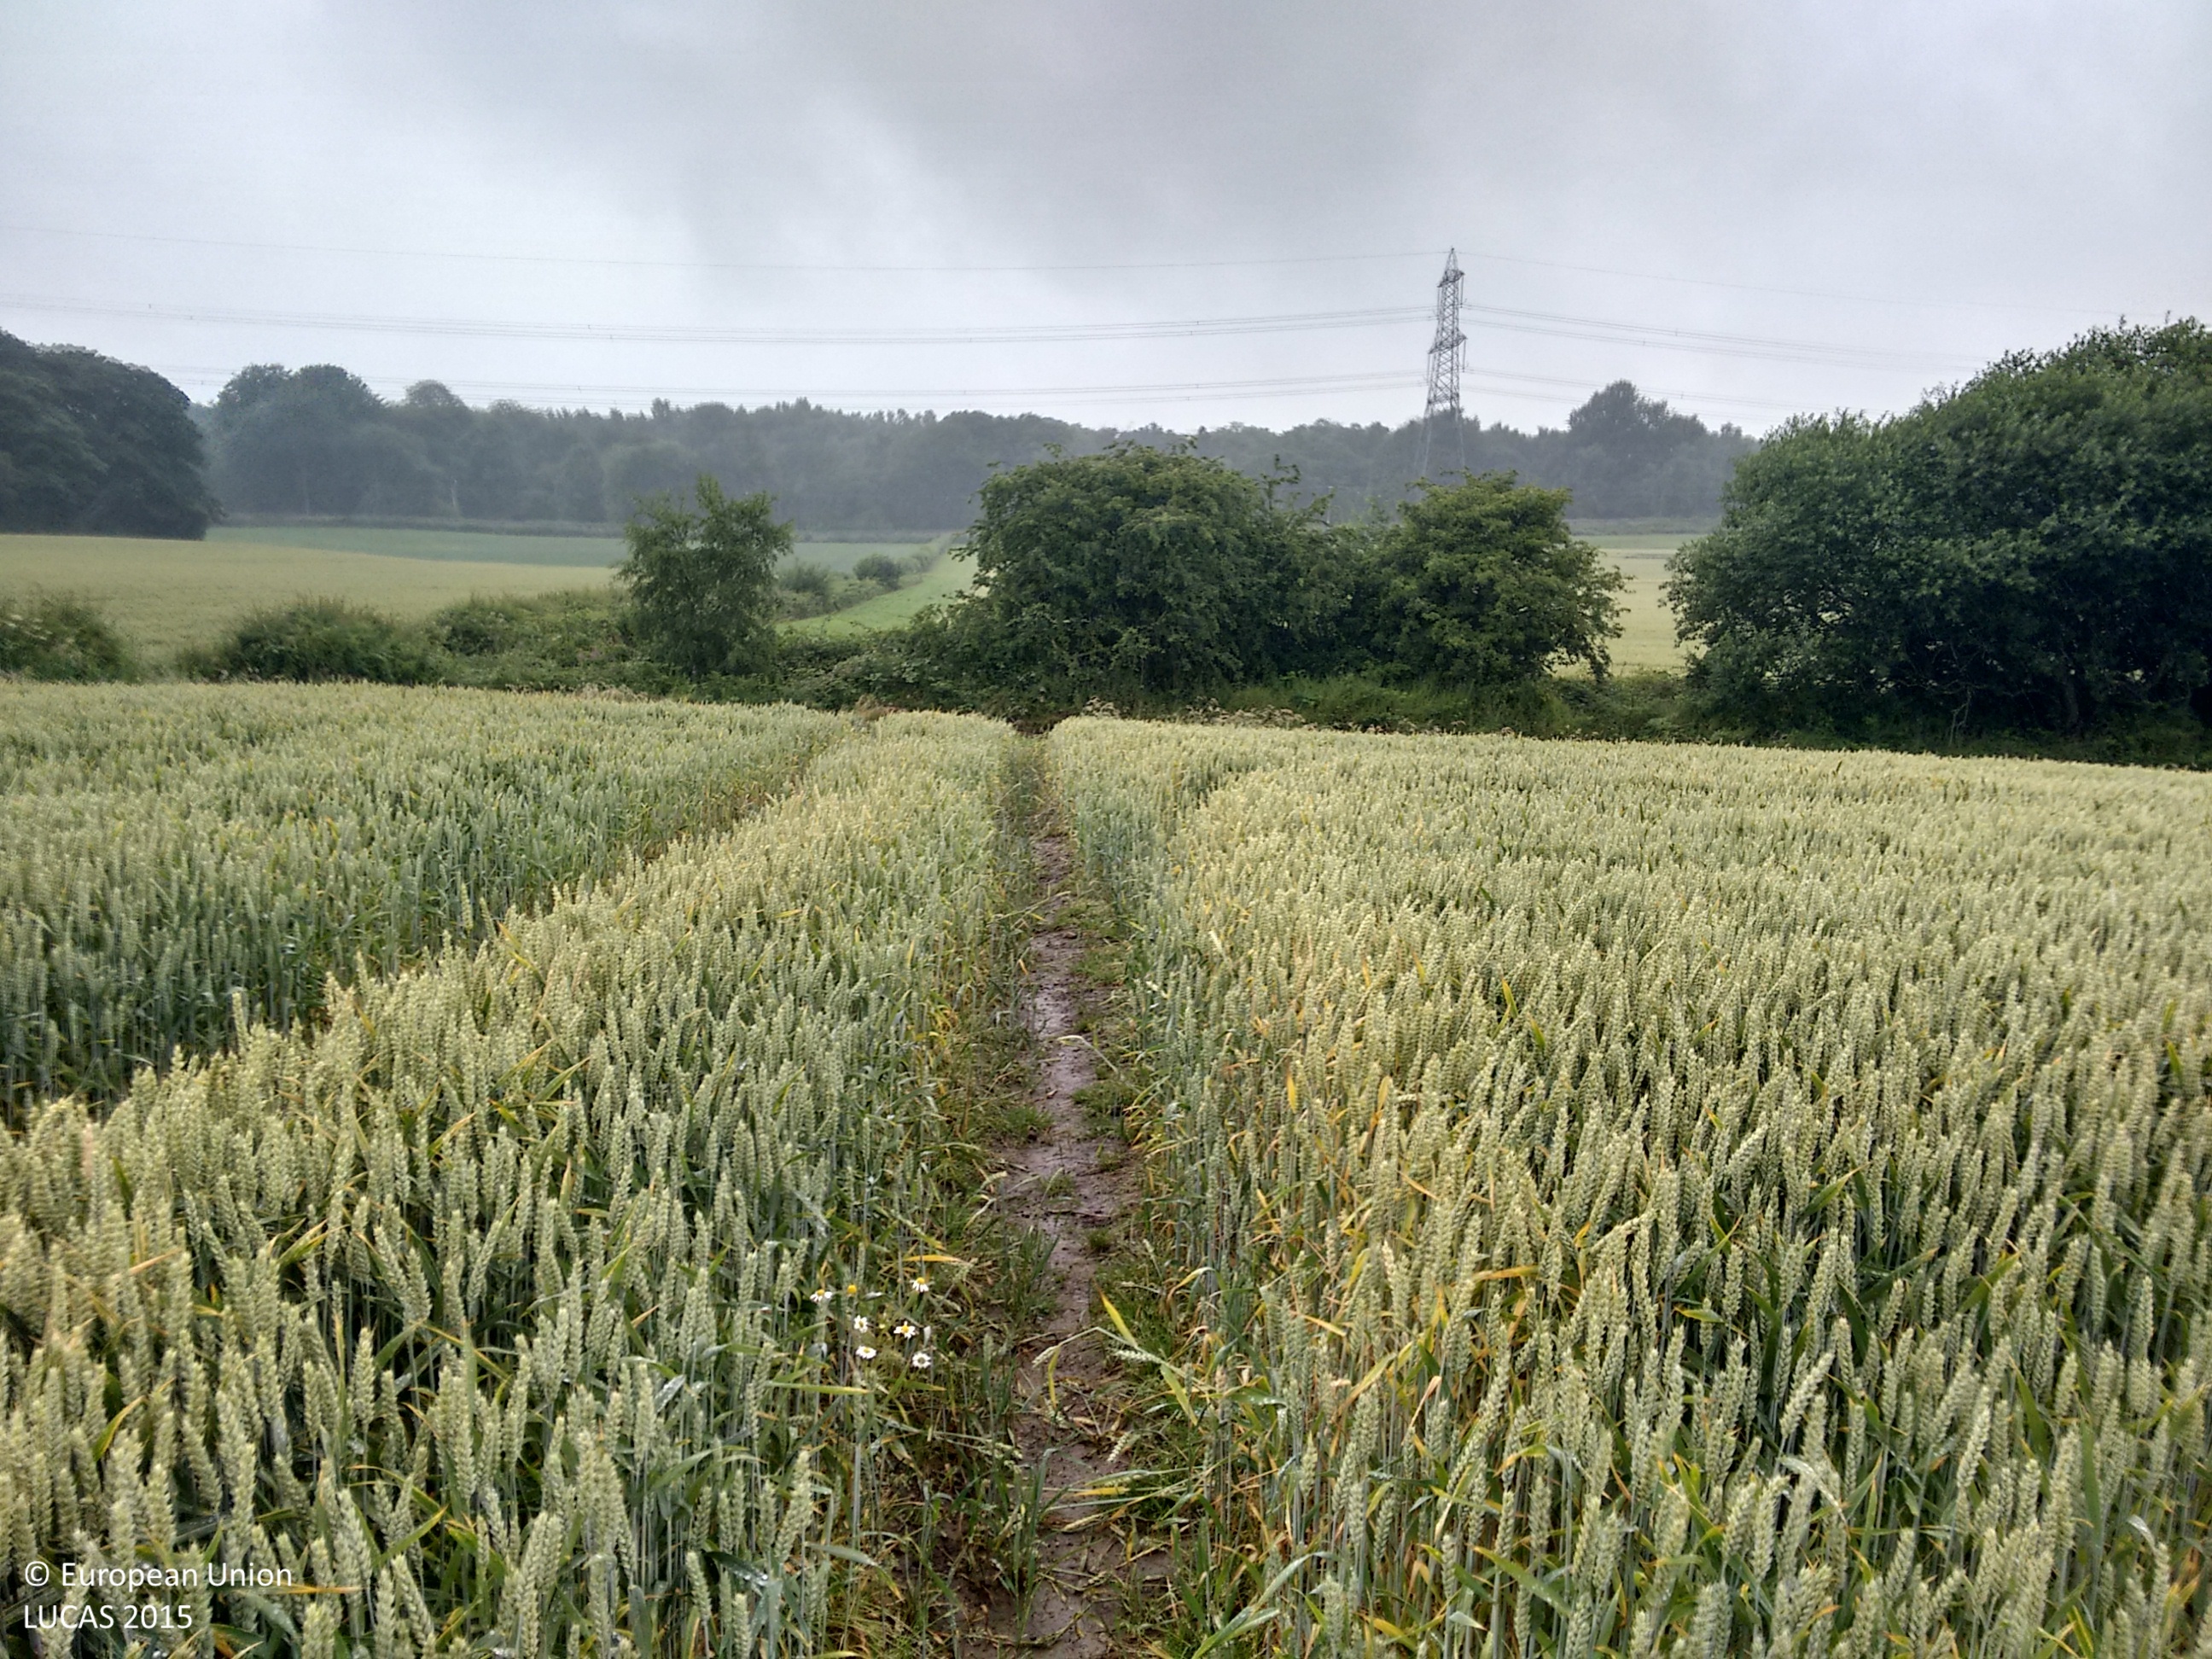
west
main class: Cropland
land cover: Common wheat
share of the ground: > 75 %
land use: Agriculture (excluding fallow land and kitchen gardens)
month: July
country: GB
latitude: 53.4483
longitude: -2.7938
